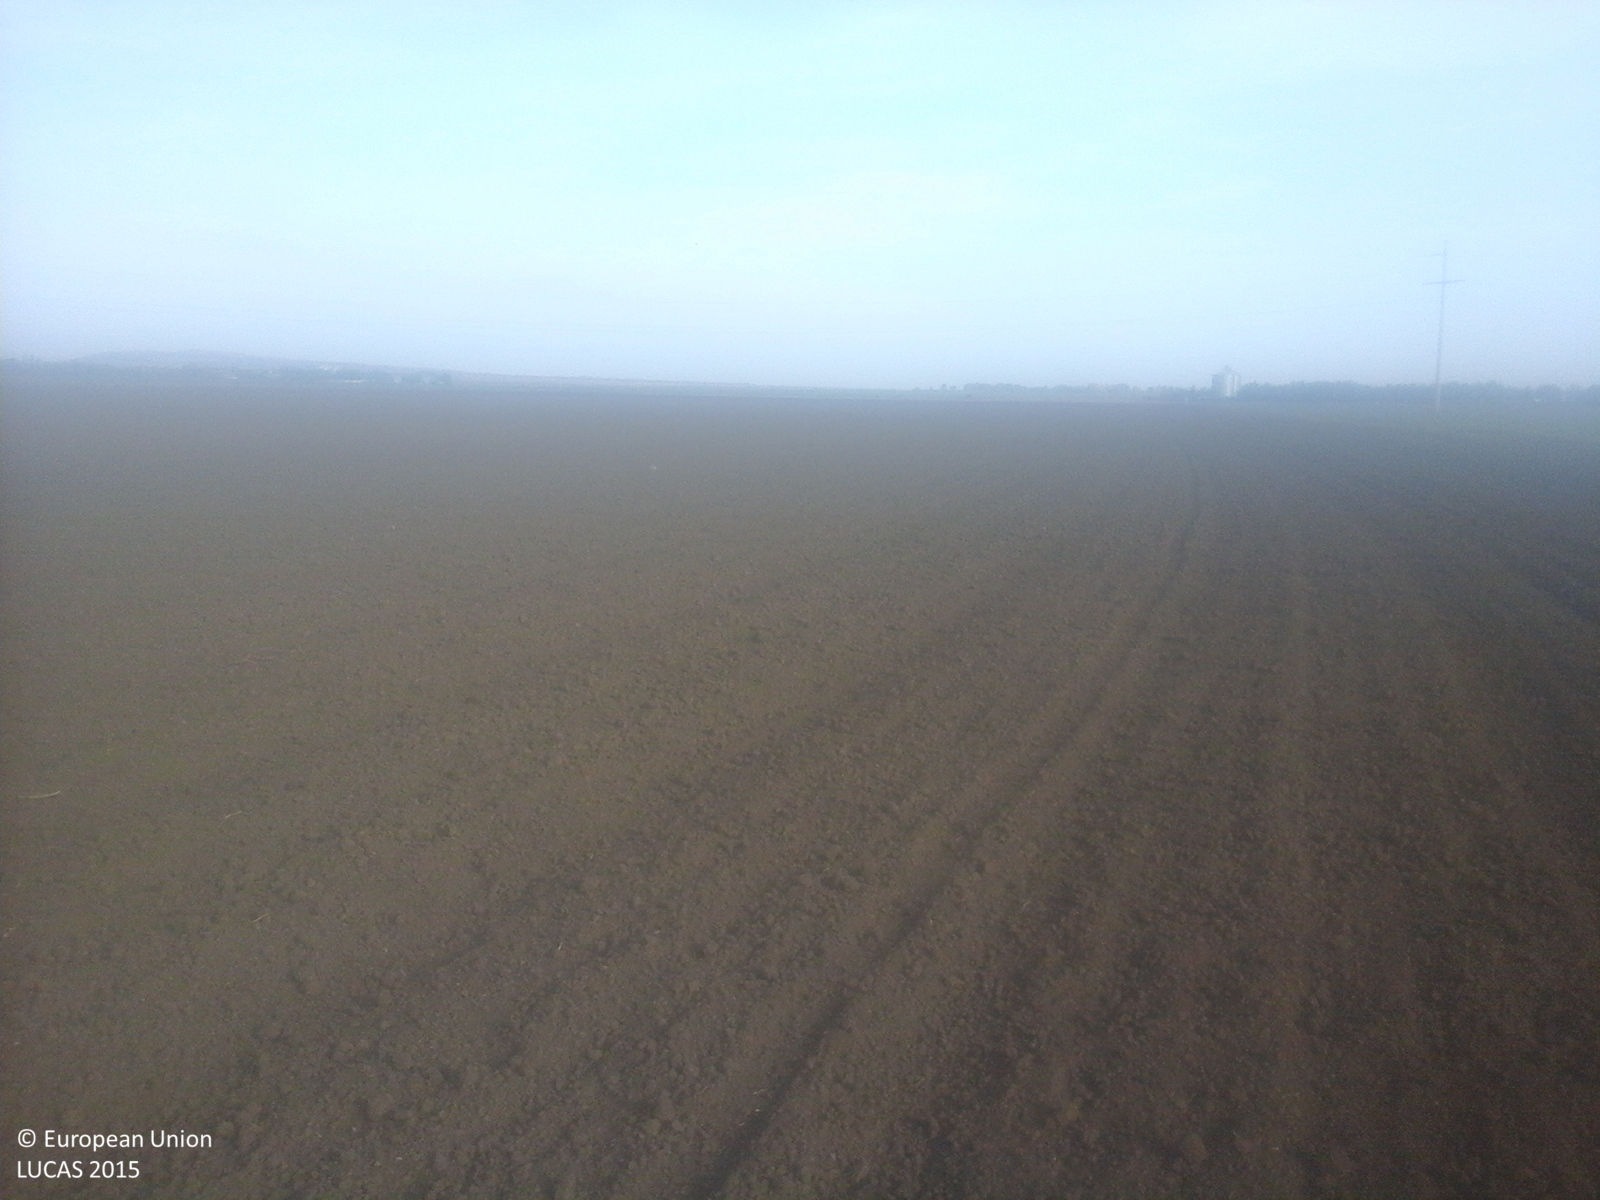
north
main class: Cropland
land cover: Common wheat
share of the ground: < 10 %
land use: Agriculture (excluding fallow land and kitchen gardens)
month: October
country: RO
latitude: 45.4117
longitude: 27.0443
